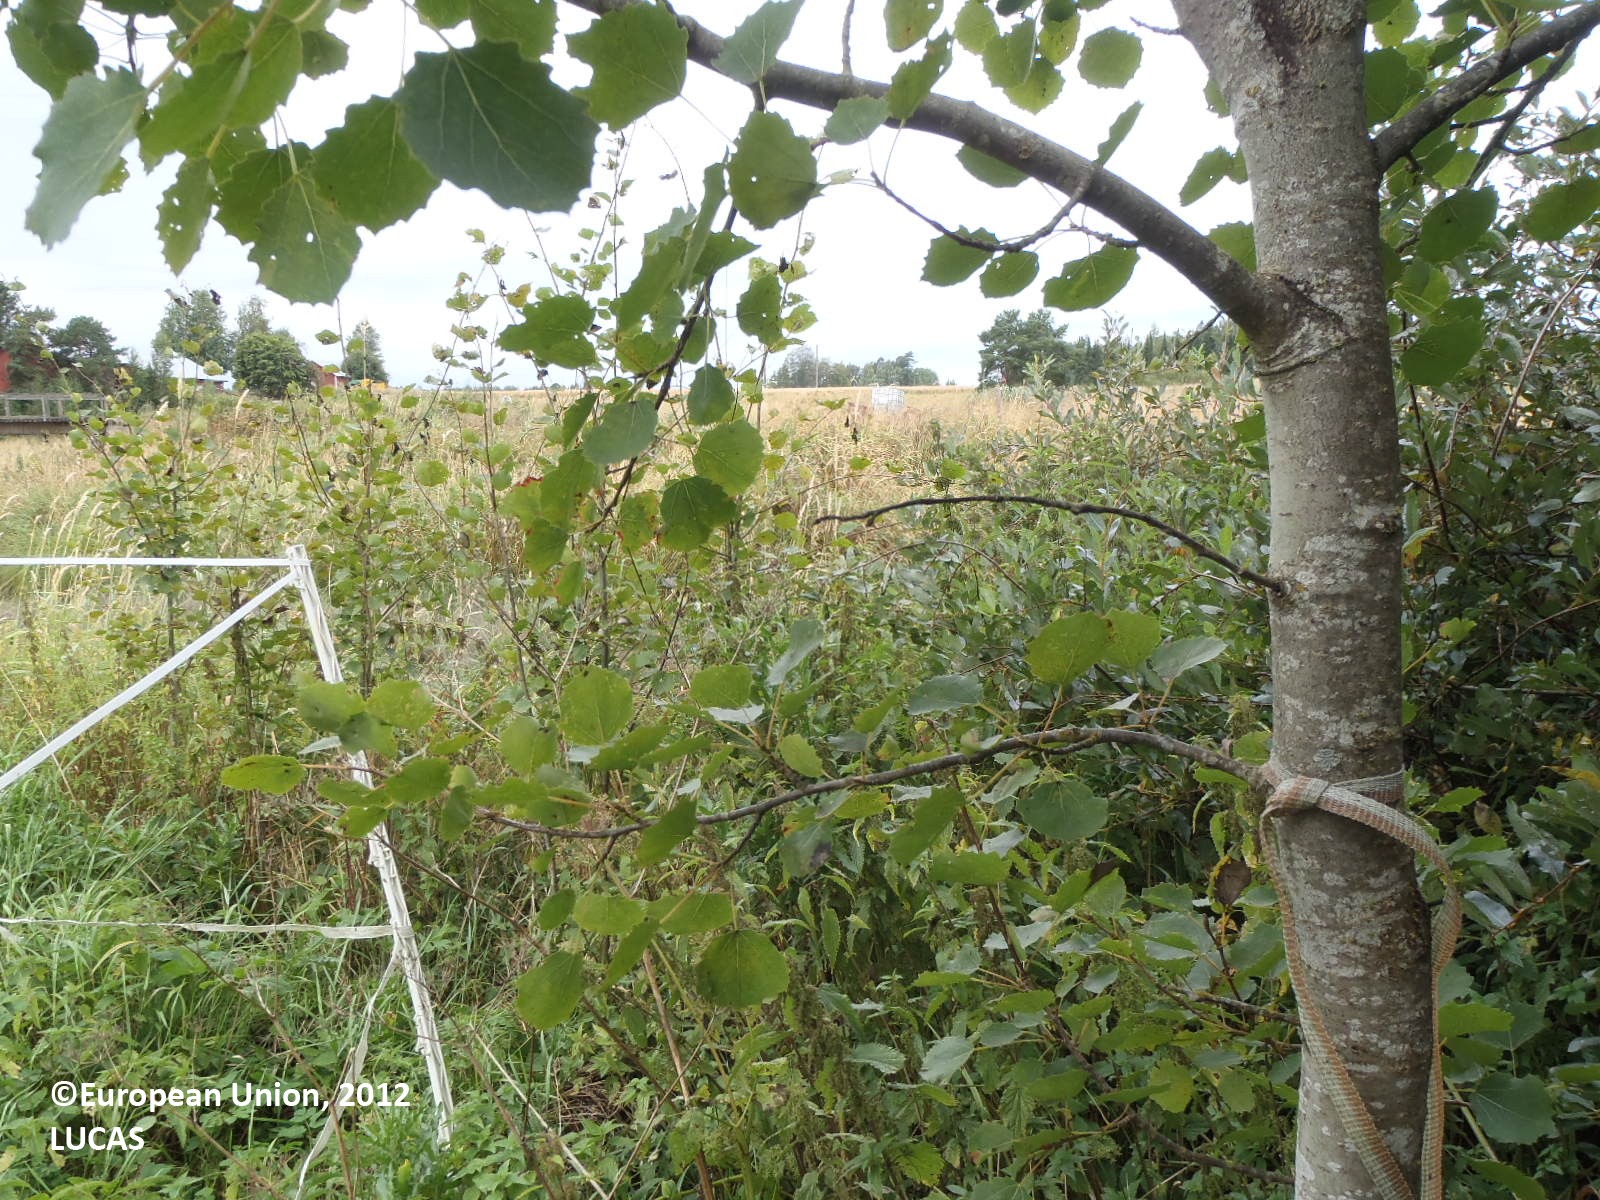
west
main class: Grassland
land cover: Grassland without tree/shrub cover
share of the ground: > 75 %
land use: Agriculture (excluding fallow land and kitchen gardens)
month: September
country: FI
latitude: 60.7424
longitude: 22.6353
